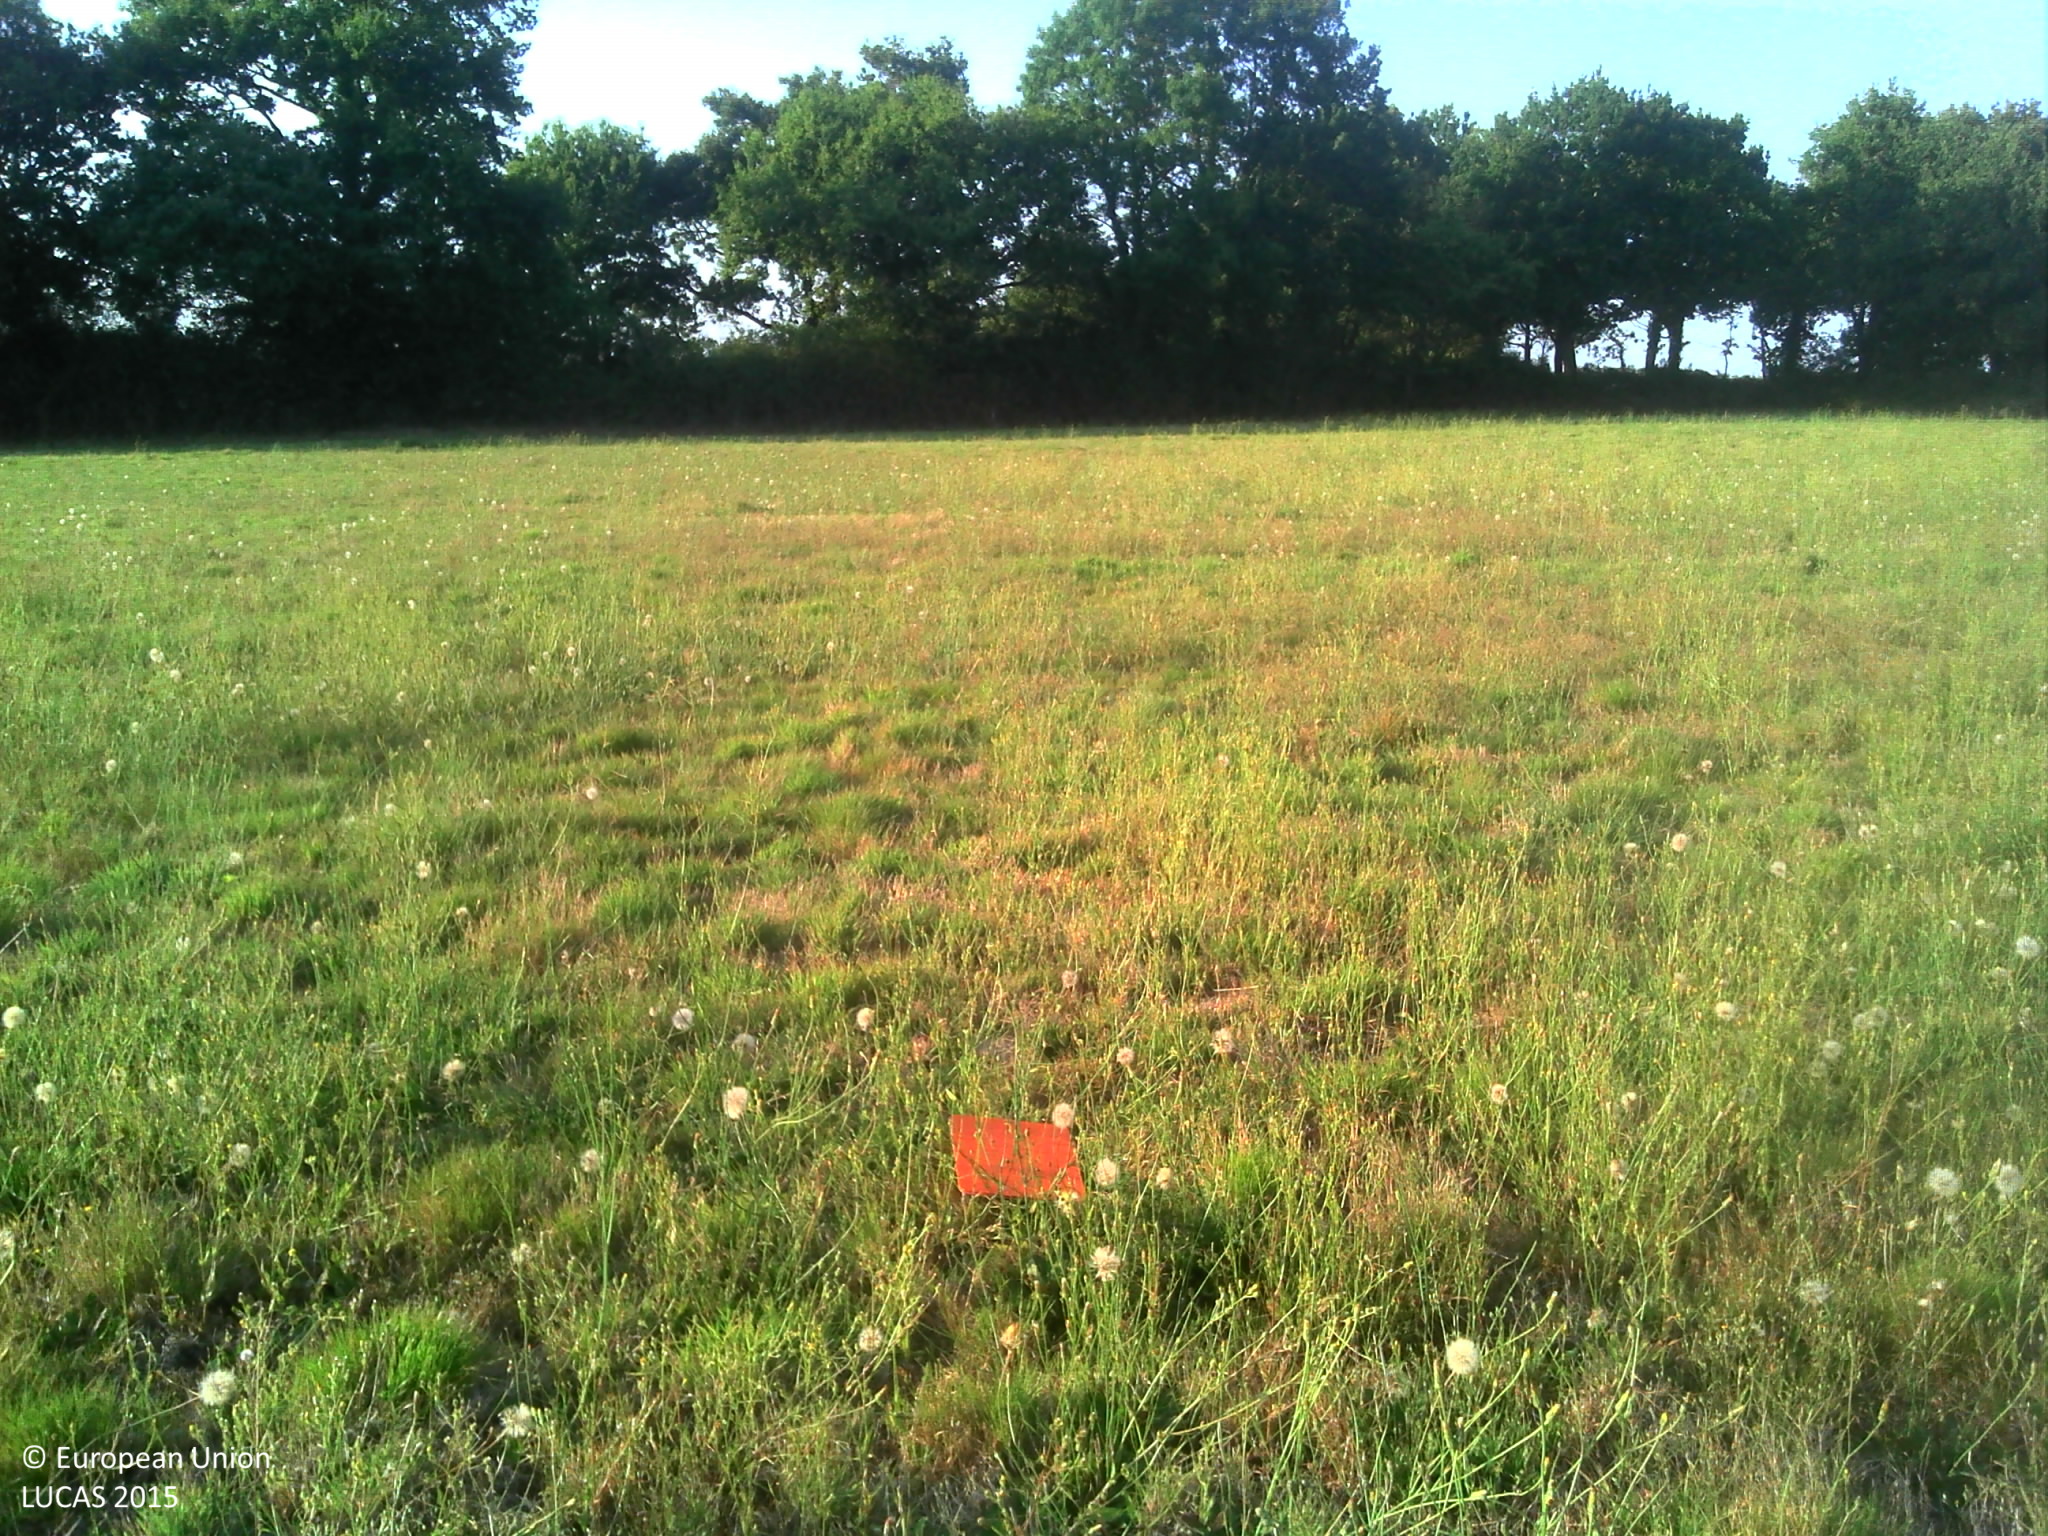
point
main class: Grassland
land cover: Grassland without tree/shrub cover
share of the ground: > 75 %
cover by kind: herbaceous plants 100 %
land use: Agriculture (excluding fallow land and kitchen gardens)
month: July
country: FR
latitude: 46.4917
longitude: -1.6742
